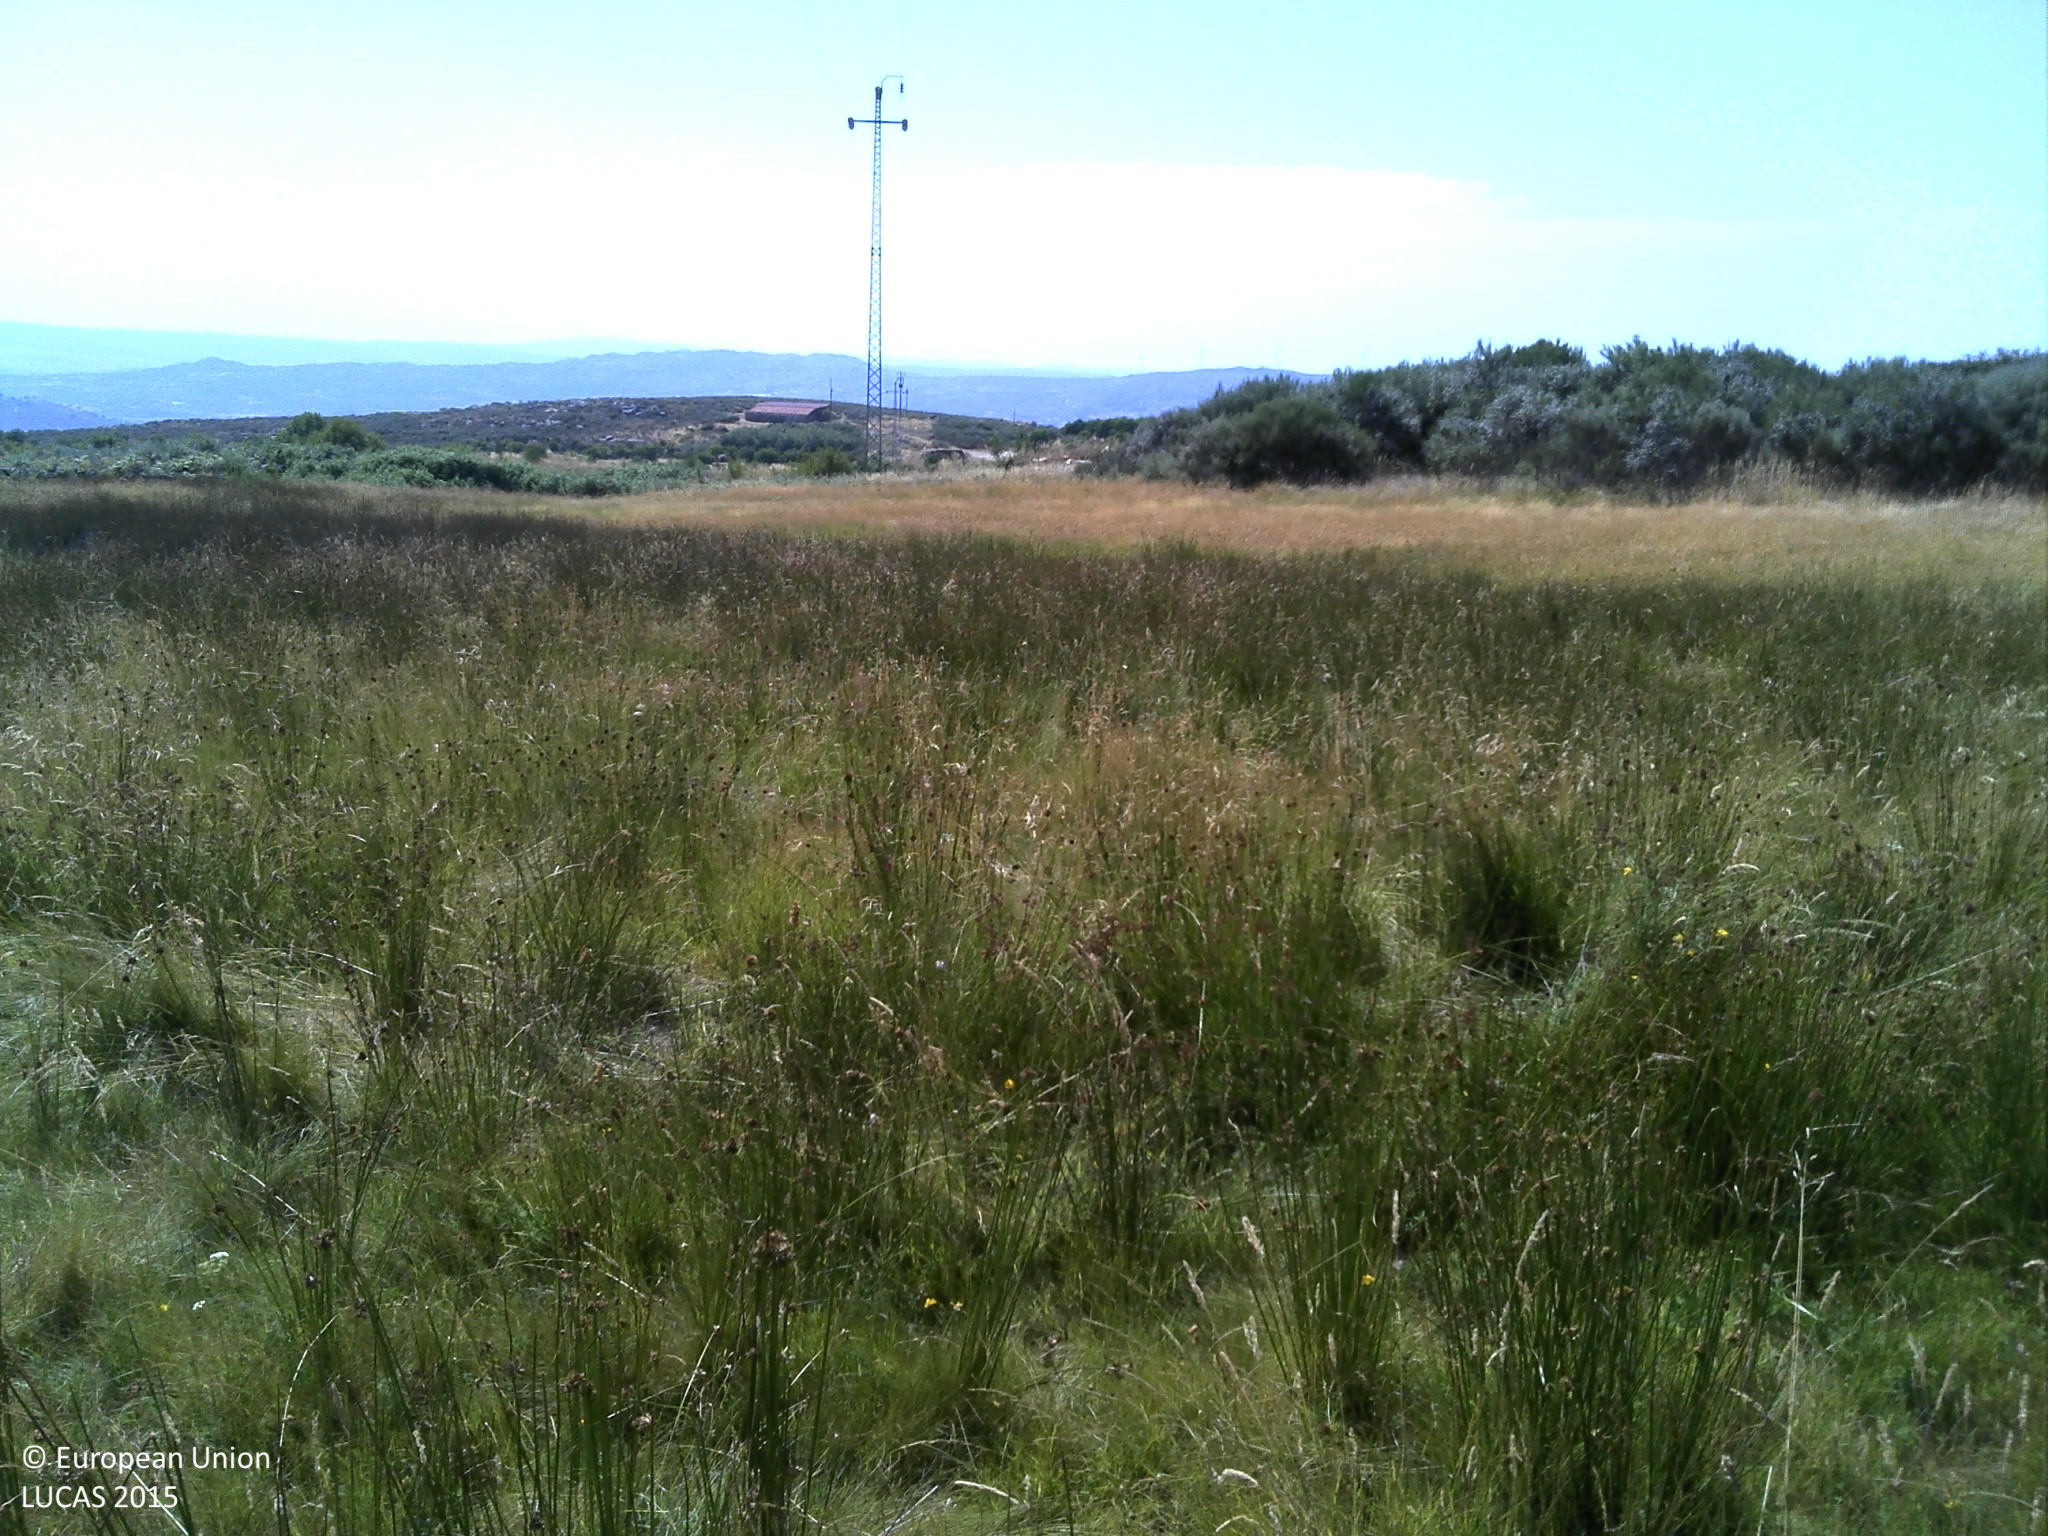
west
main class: Grassland
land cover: Grassland without tree/shrub cover
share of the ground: > 75 %
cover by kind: herbaceous plants 90 %, unconsolidated bare surface 10 %
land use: Agriculture (excluding fallow land and kitchen gardens)
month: July
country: PT
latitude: 41.0334
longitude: -7.4488
